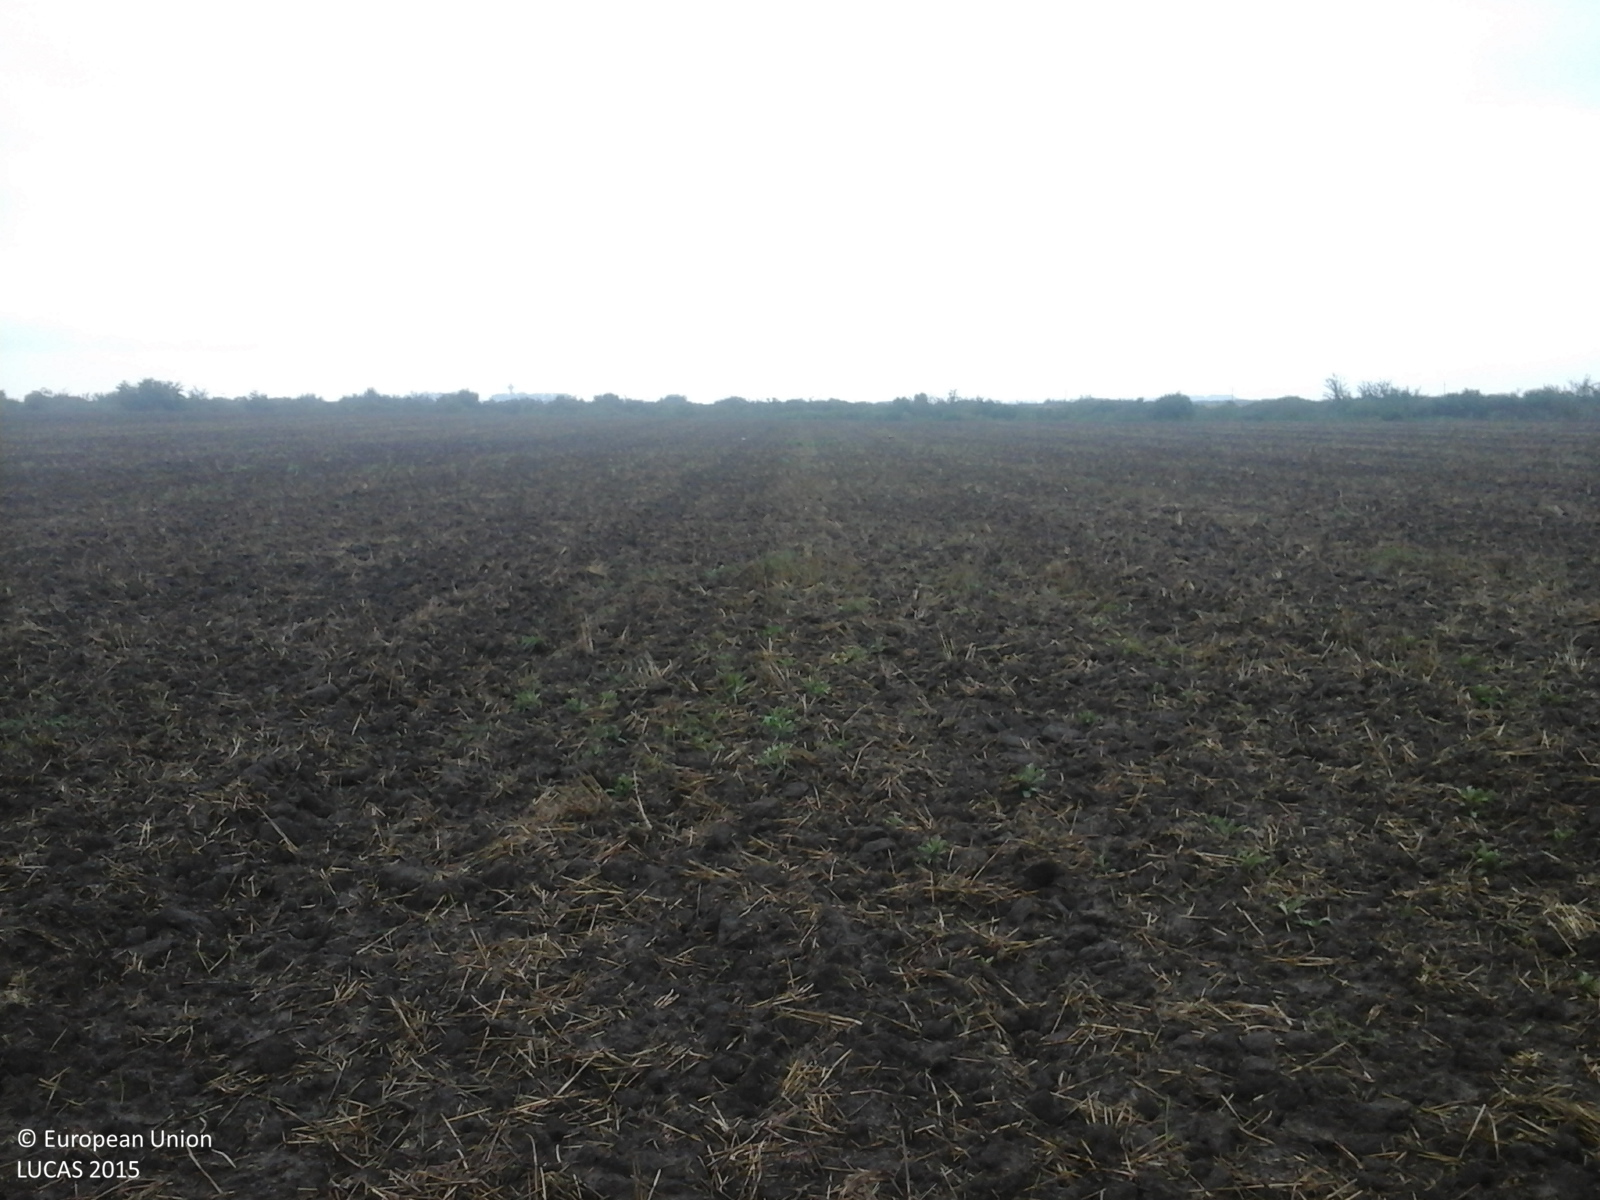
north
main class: Cropland
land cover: Common wheat
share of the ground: < 10 %
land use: Agriculture (excluding fallow land and kitchen gardens)
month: August
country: RO
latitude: 45.6006
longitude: 21.1701
